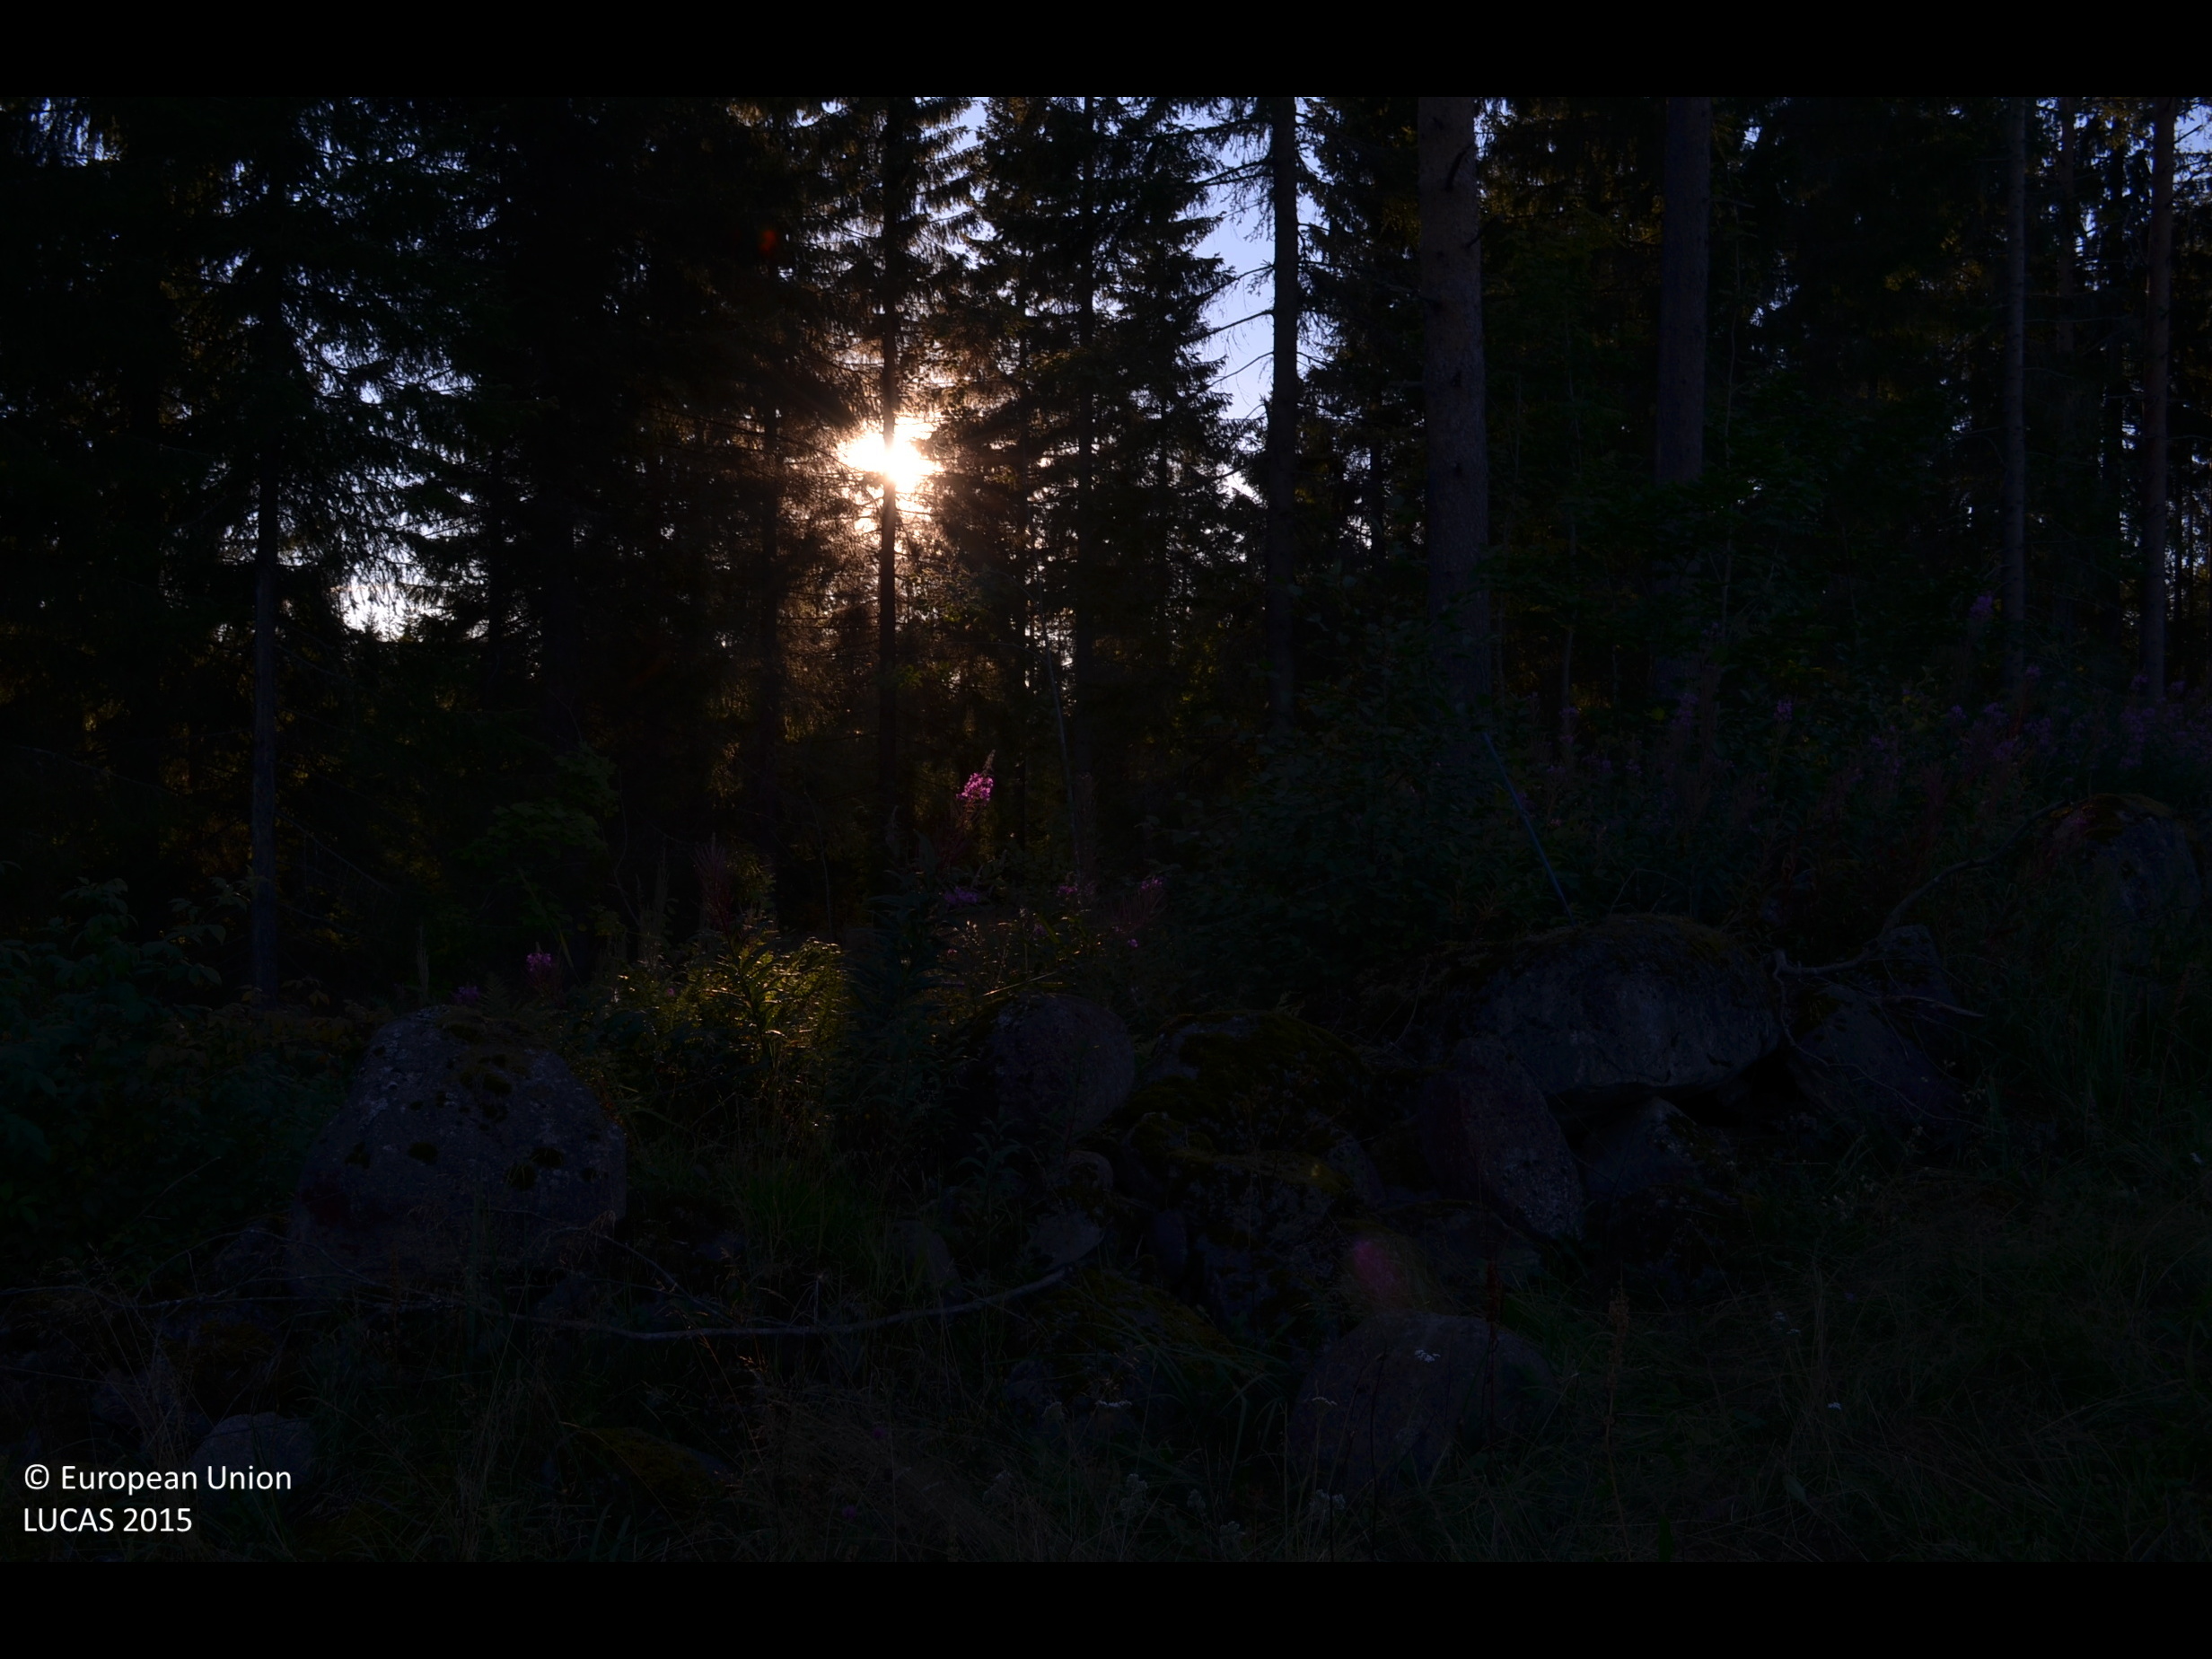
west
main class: Cropland
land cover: Temporary grasslands
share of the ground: > 75 %
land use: Agriculture (excluding fallow land and kitchen gardens)
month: August
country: FI
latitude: 62.3068
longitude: 24.3421
